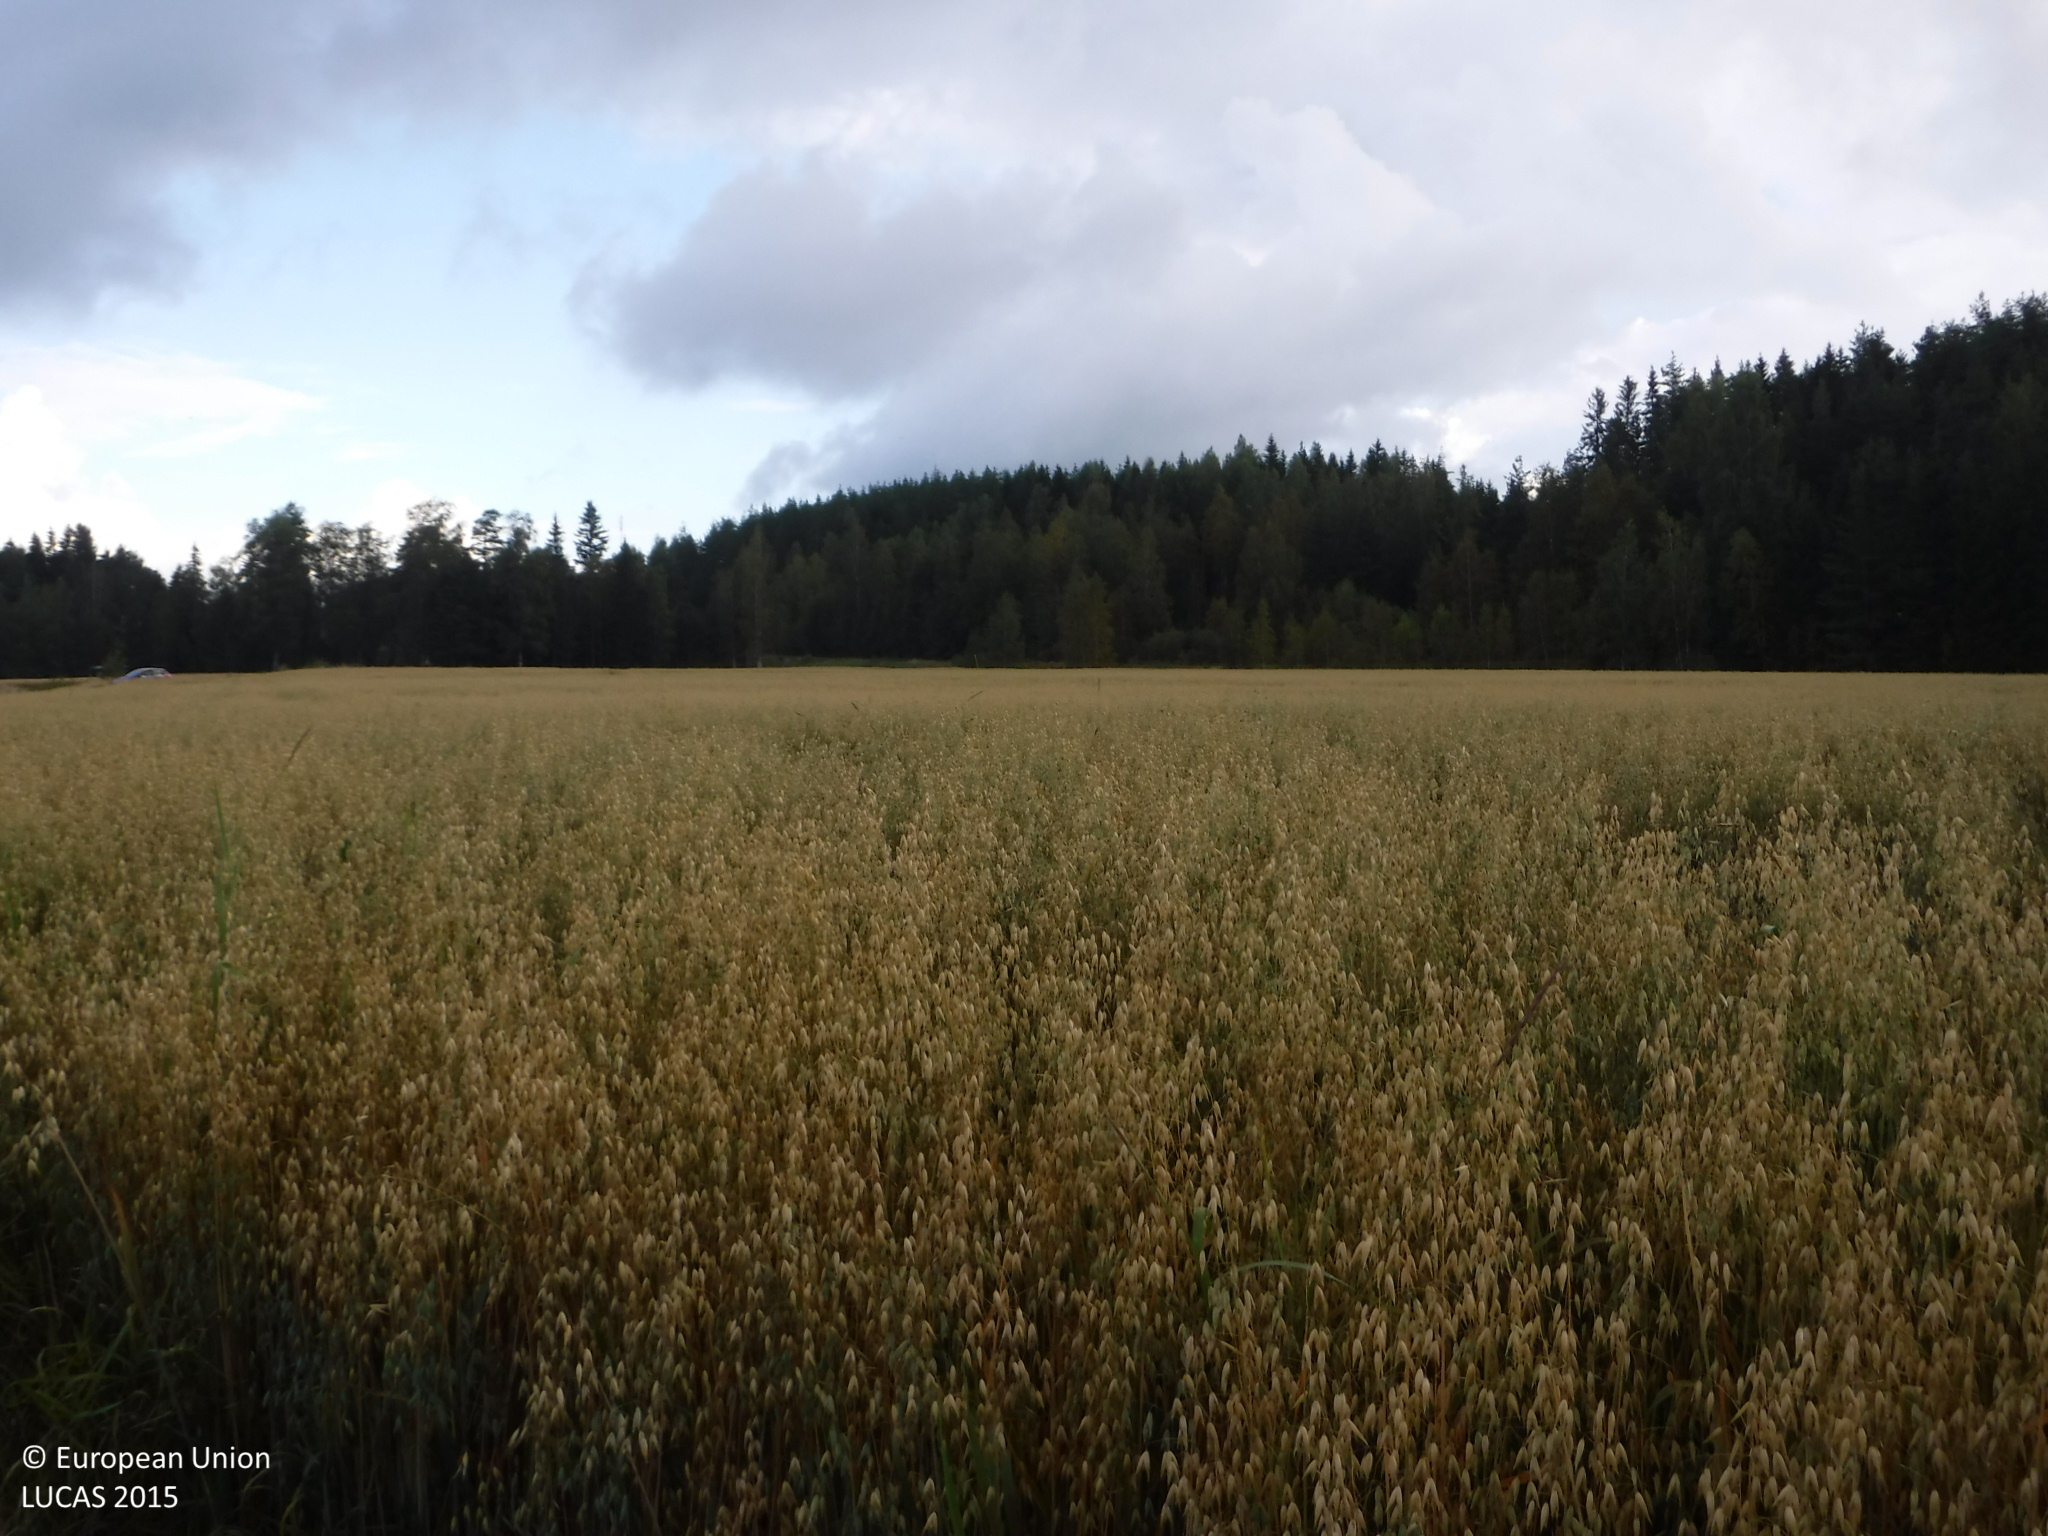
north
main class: Cropland
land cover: Common wheat
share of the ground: > 75 %
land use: Agriculture (excluding fallow land and kitchen gardens)
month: September
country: FI
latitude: 61.3189
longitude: 22.5235
